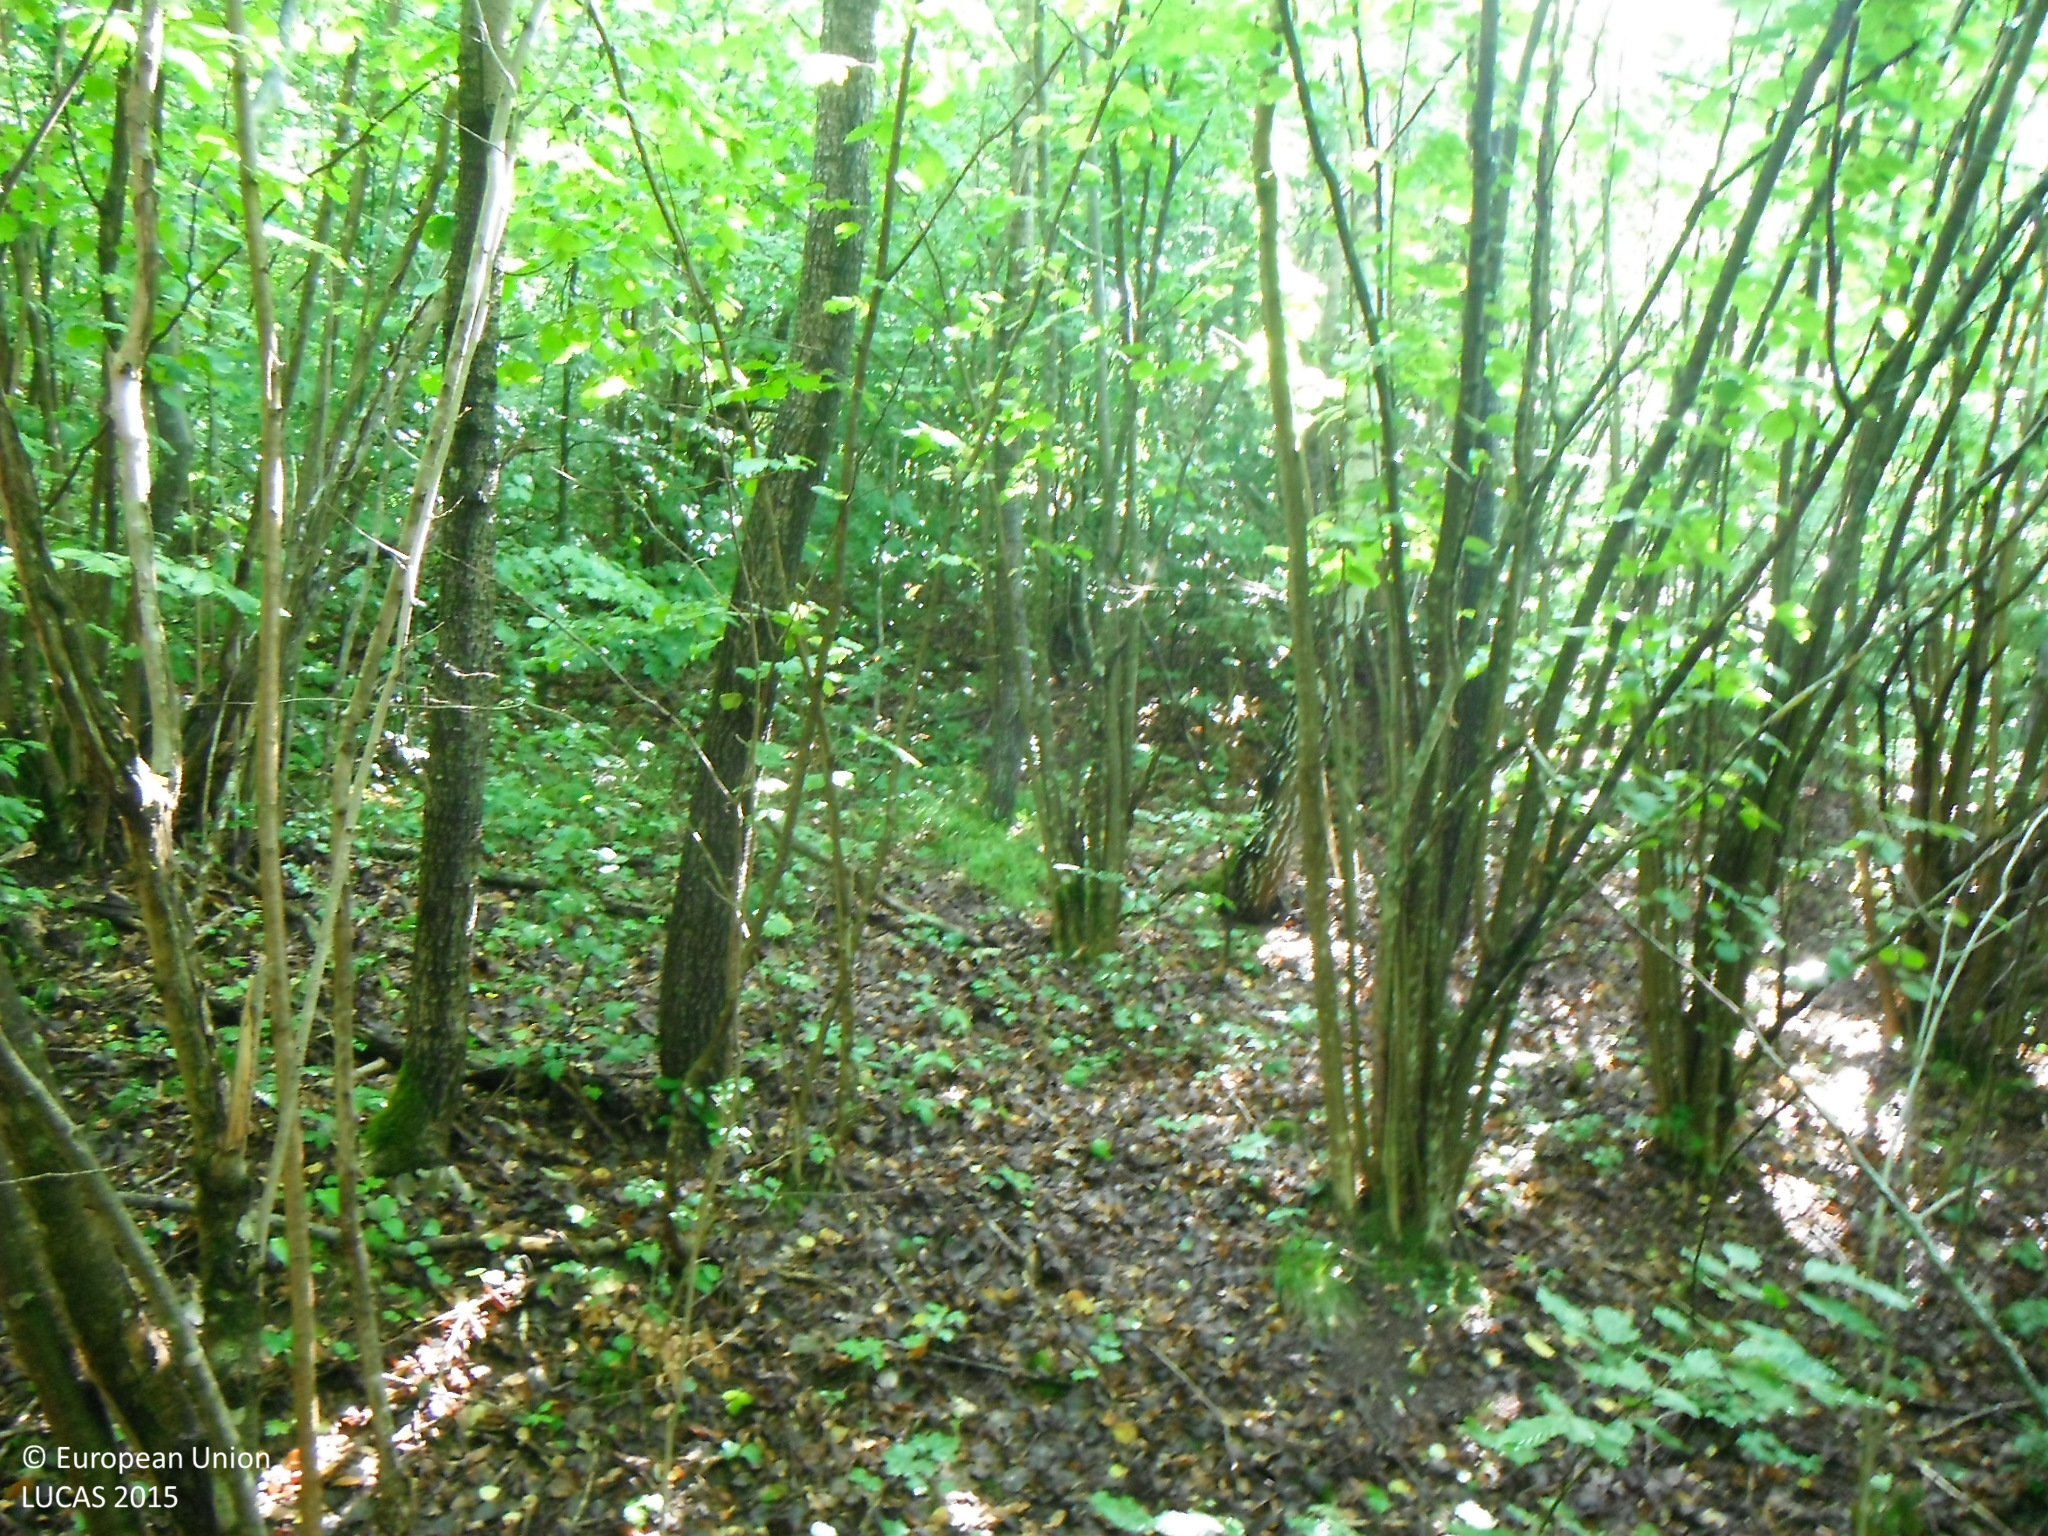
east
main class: Woodland
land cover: Broadleaved woodland
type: mesophytic deciduous forest
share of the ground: > 75 %
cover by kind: broadleaved forest trees 100 %
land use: Semi-natural and natural areas not in use
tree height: > 5 m
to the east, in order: Broadleaved woodland; Grassland with sparse tree/shrub cover; Broadleaved woodland; Grassland without tree/shrub cover; Broadleaved woodland; Grassland without tree/shrub cover; Broadleaved woodland; Grassland without tree/shrub cover; Broadleaved woodland
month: July
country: SK
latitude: 48.8538
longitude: 19.6078
